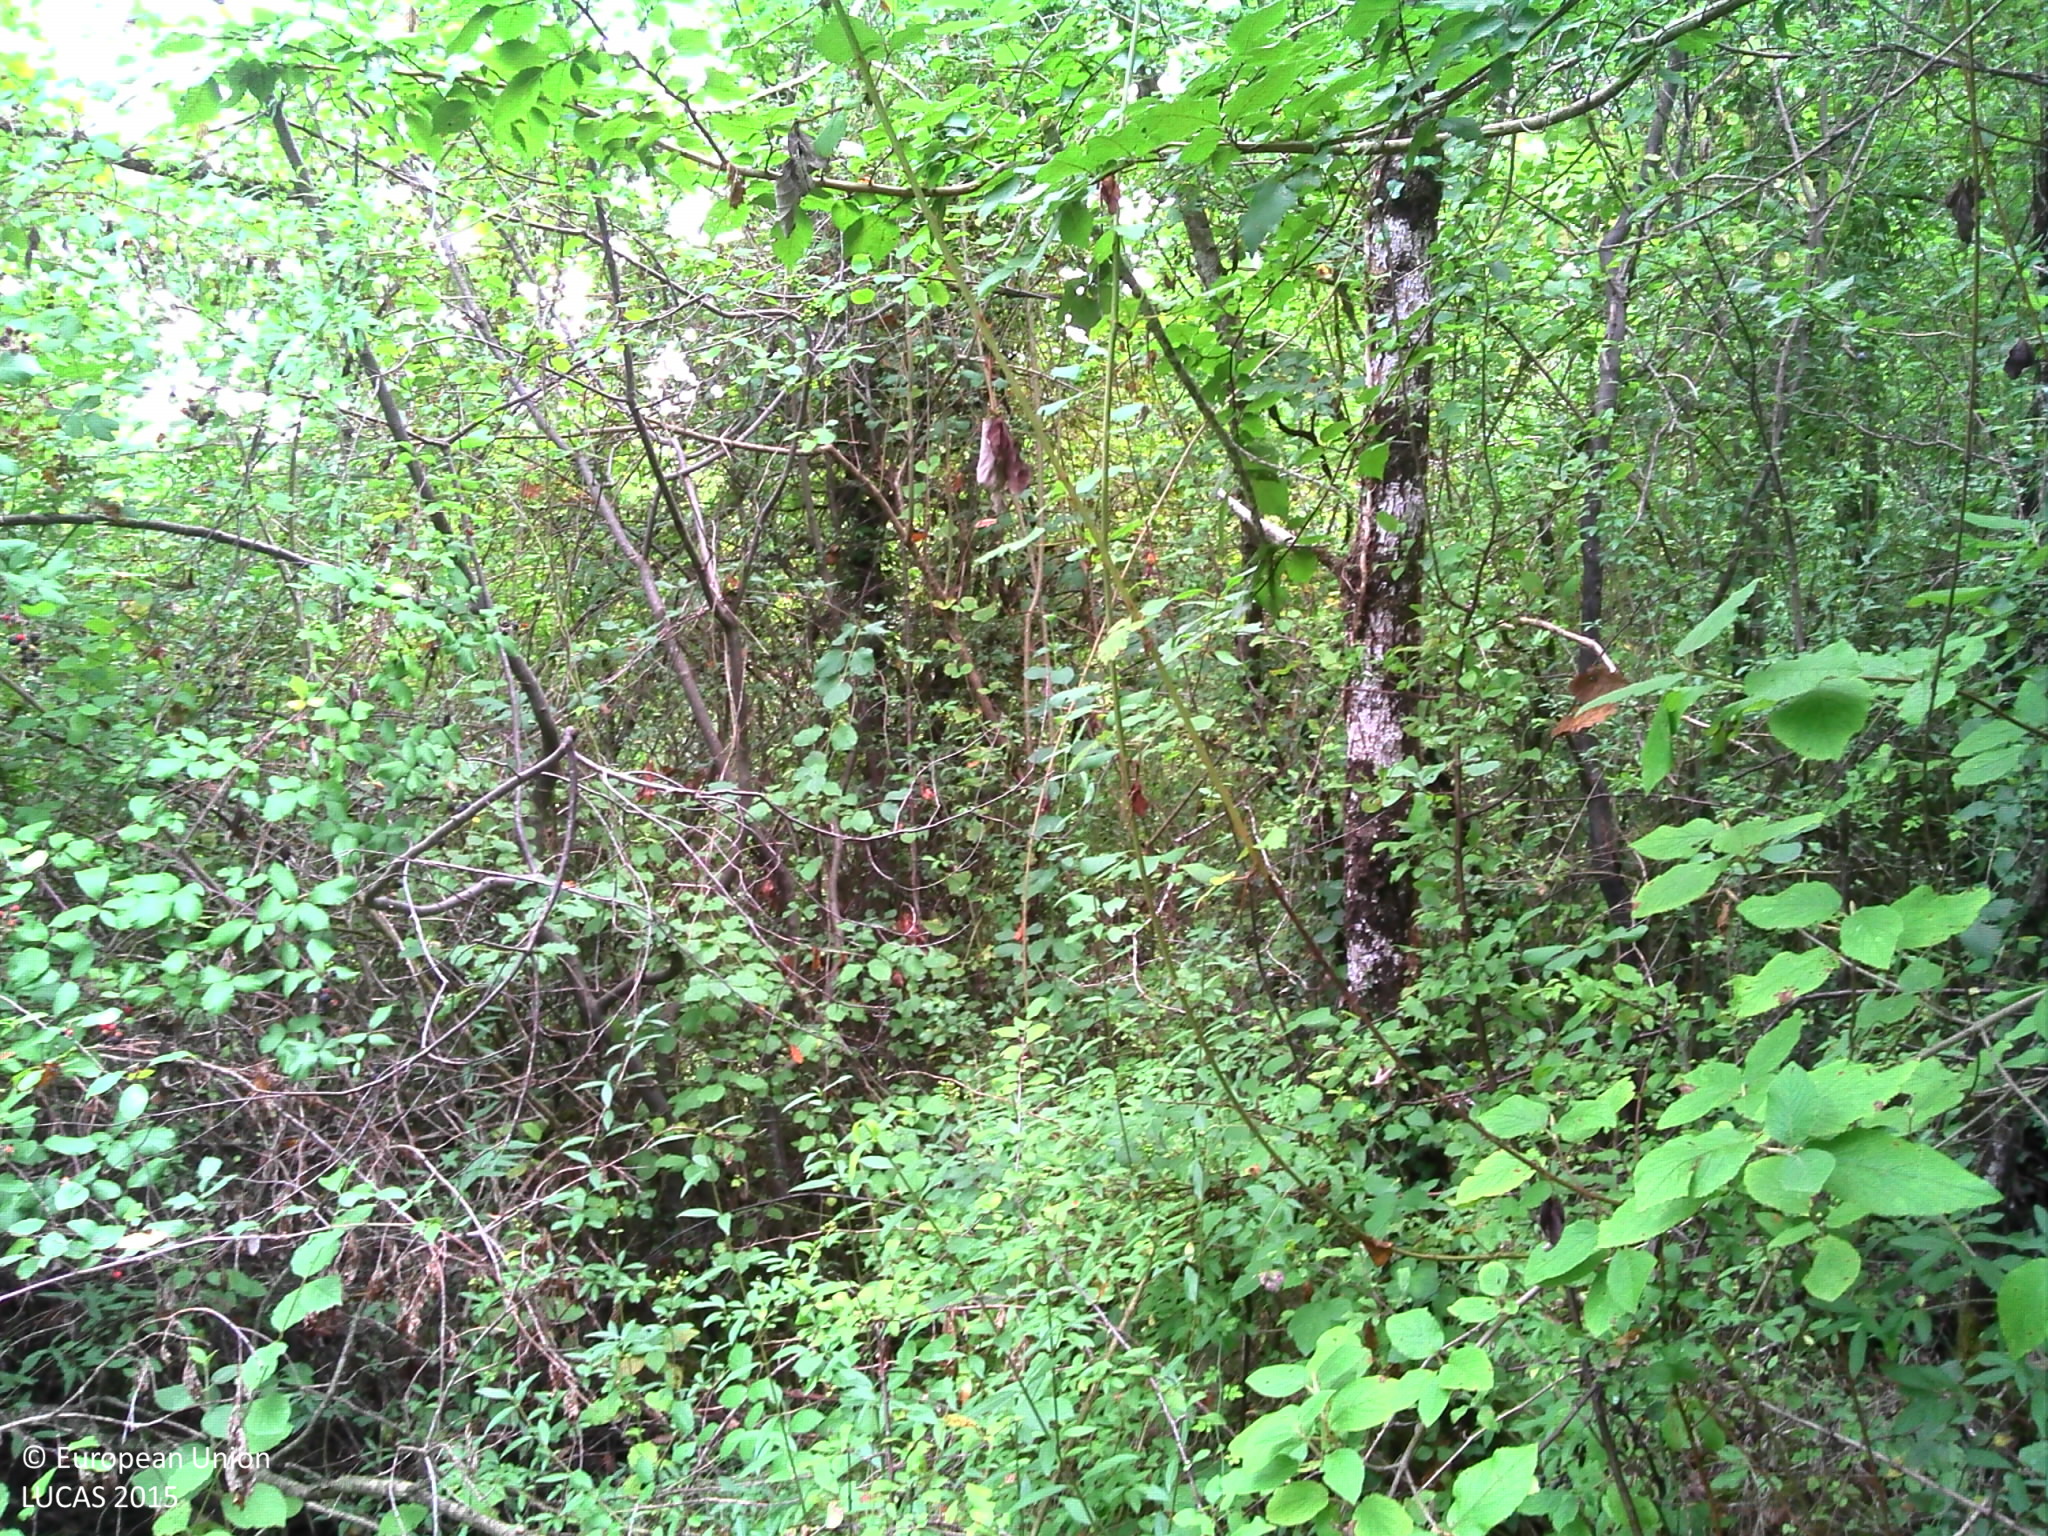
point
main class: Woodland
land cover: Broadleaved woodland
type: mesophytic deciduous forest
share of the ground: > 75 %
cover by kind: broadleaved forest trees 70 %, shrubs 20 %, herbaceous plants 10 %
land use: Forestry
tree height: > 5 m
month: August
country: FR
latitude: 45.2872
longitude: 0.4381
